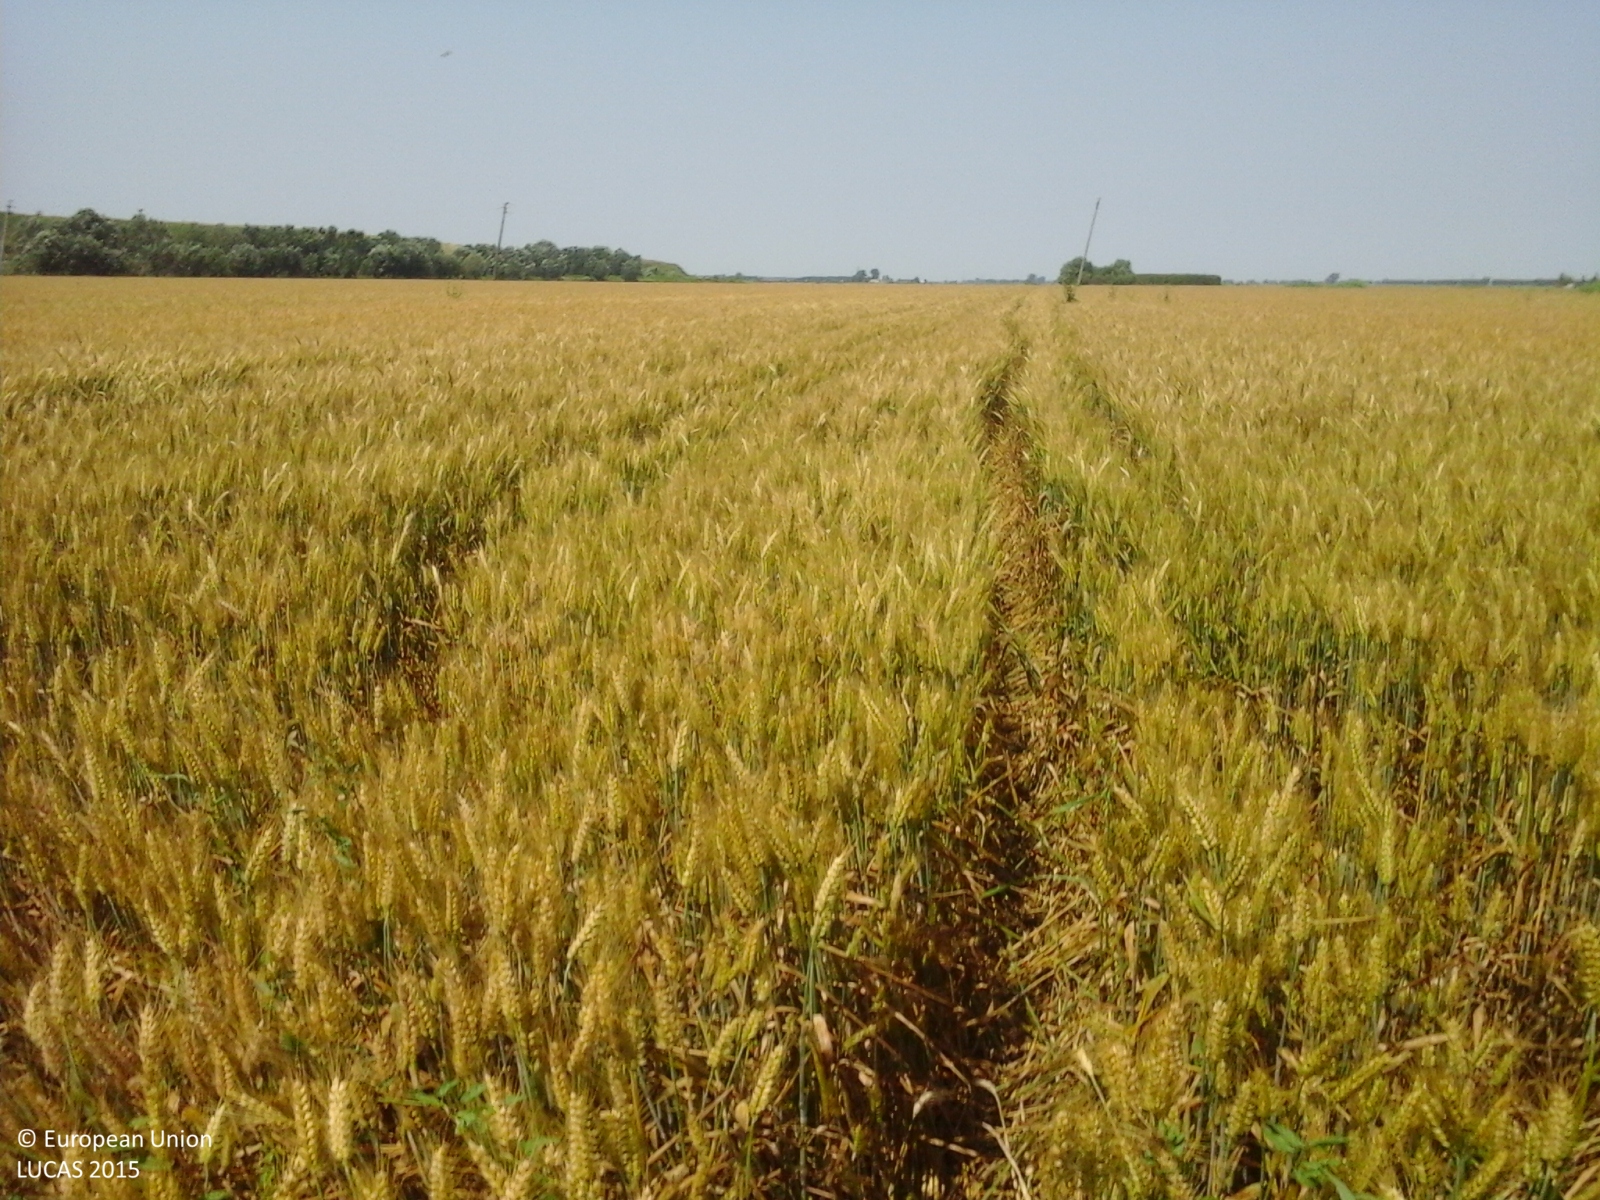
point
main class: Cropland
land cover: Common wheat
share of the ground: > 75 %
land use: Agriculture (excluding fallow land and kitchen gardens)
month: June
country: IT
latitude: 44.7246
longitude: 12.1799
